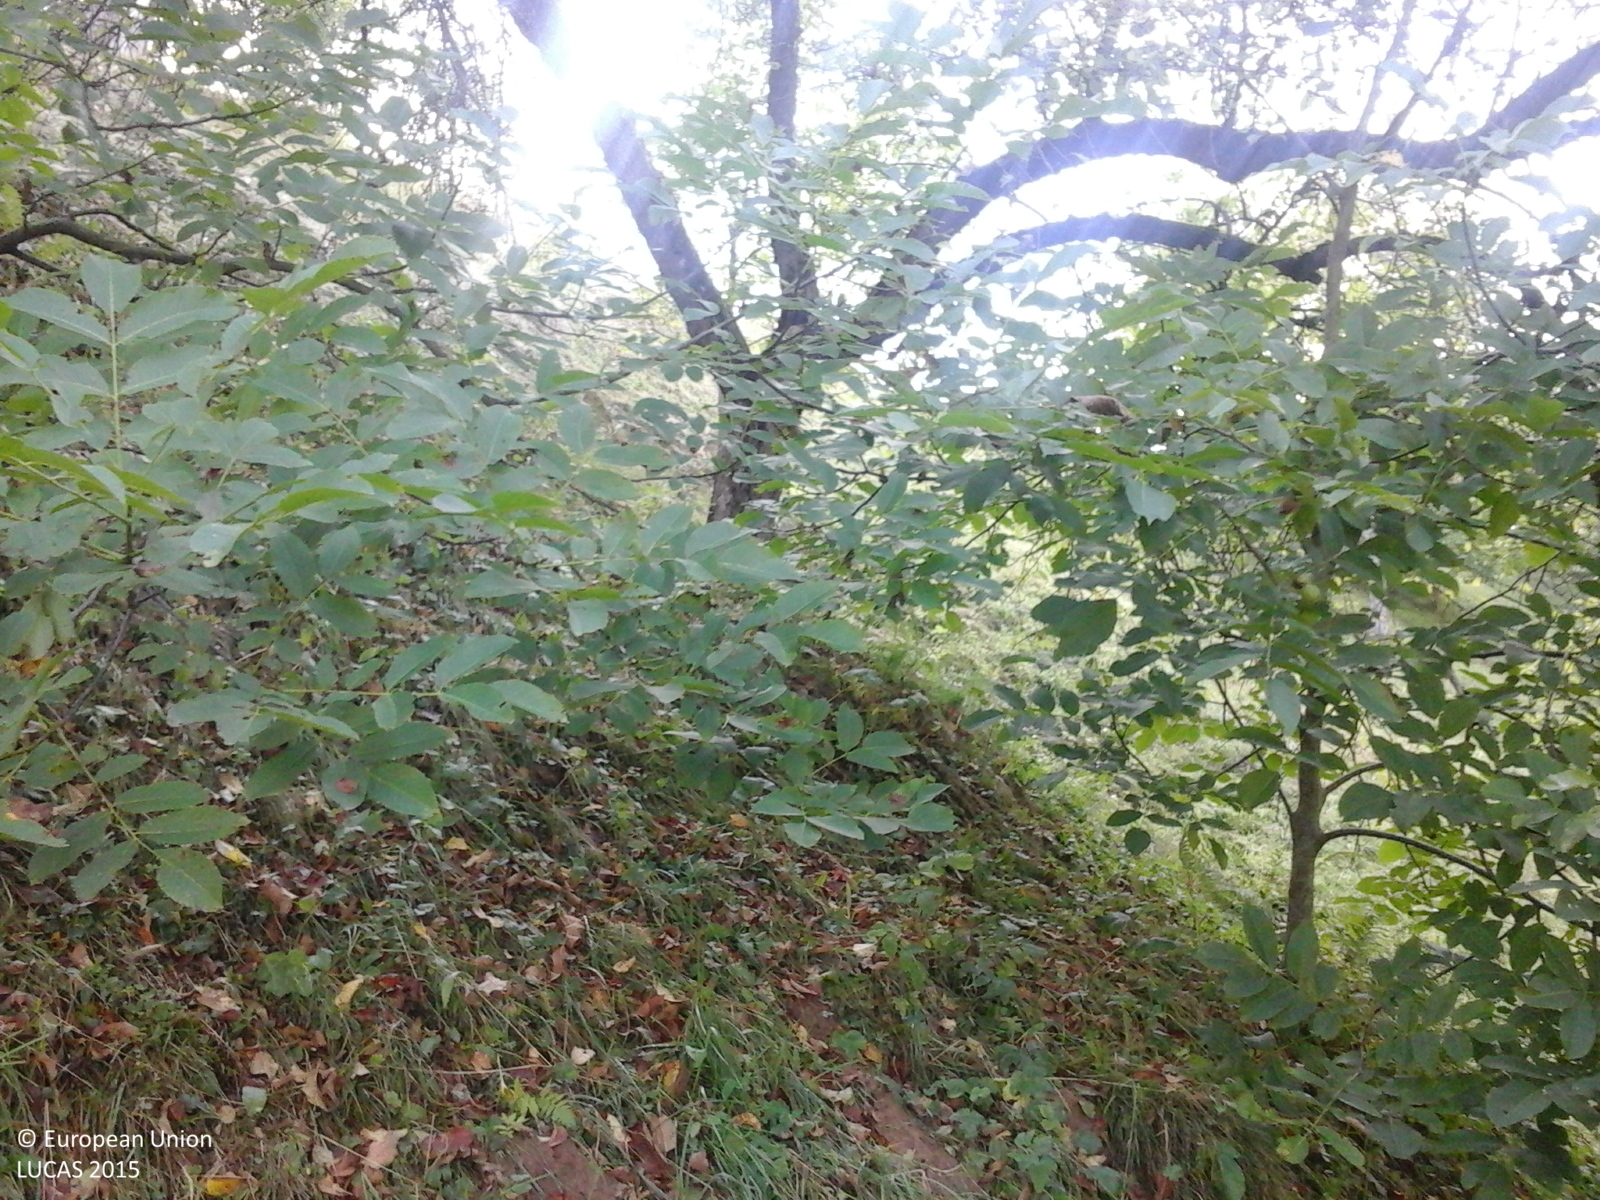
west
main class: Cropland
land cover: Other fruit trees and berries
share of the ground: 50 - 75 %
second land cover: Grassland without tree/shrub cover
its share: > 75 %
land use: Agriculture (excluding fallow land and kitchen gardens)
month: September
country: RO
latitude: 47.7940
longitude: 23.9000
